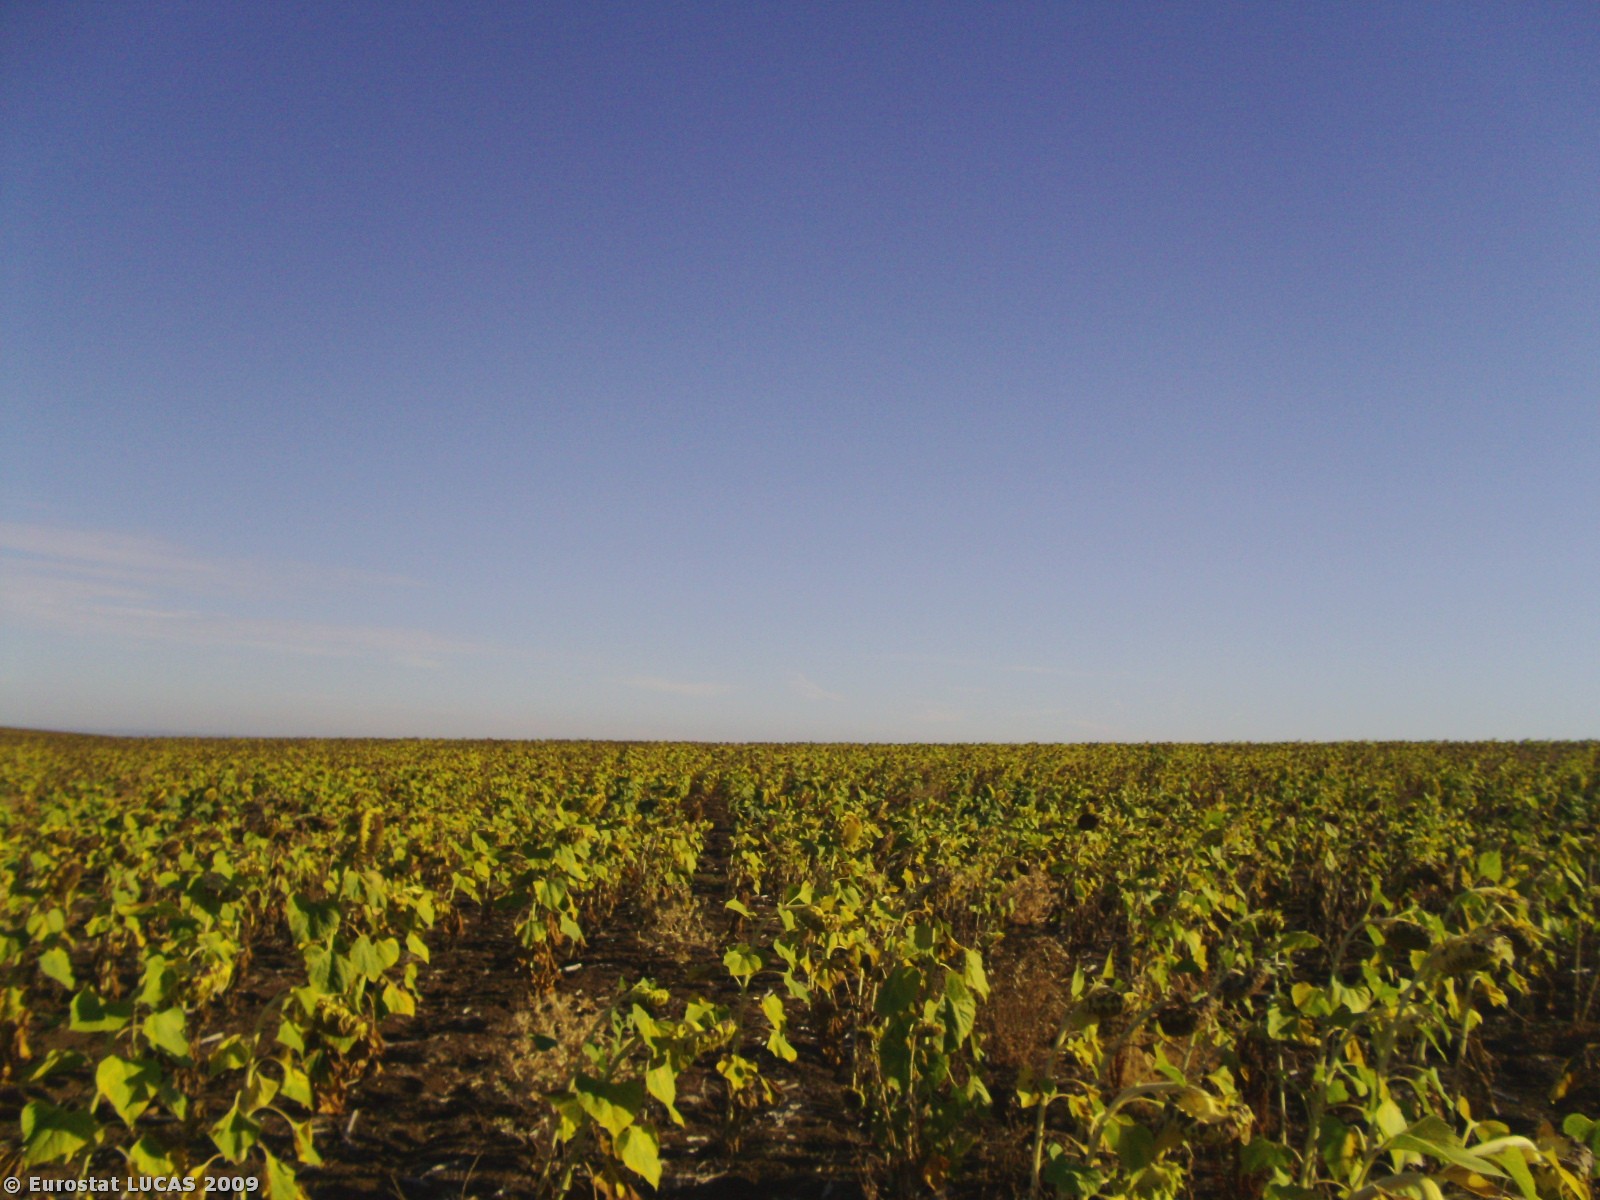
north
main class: Cropland
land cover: Sunflower
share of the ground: 50 - 75 %
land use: Agriculture (excluding fallow land and kitchen gardens)
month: August
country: PT
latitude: 37.9362
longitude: -7.5294
